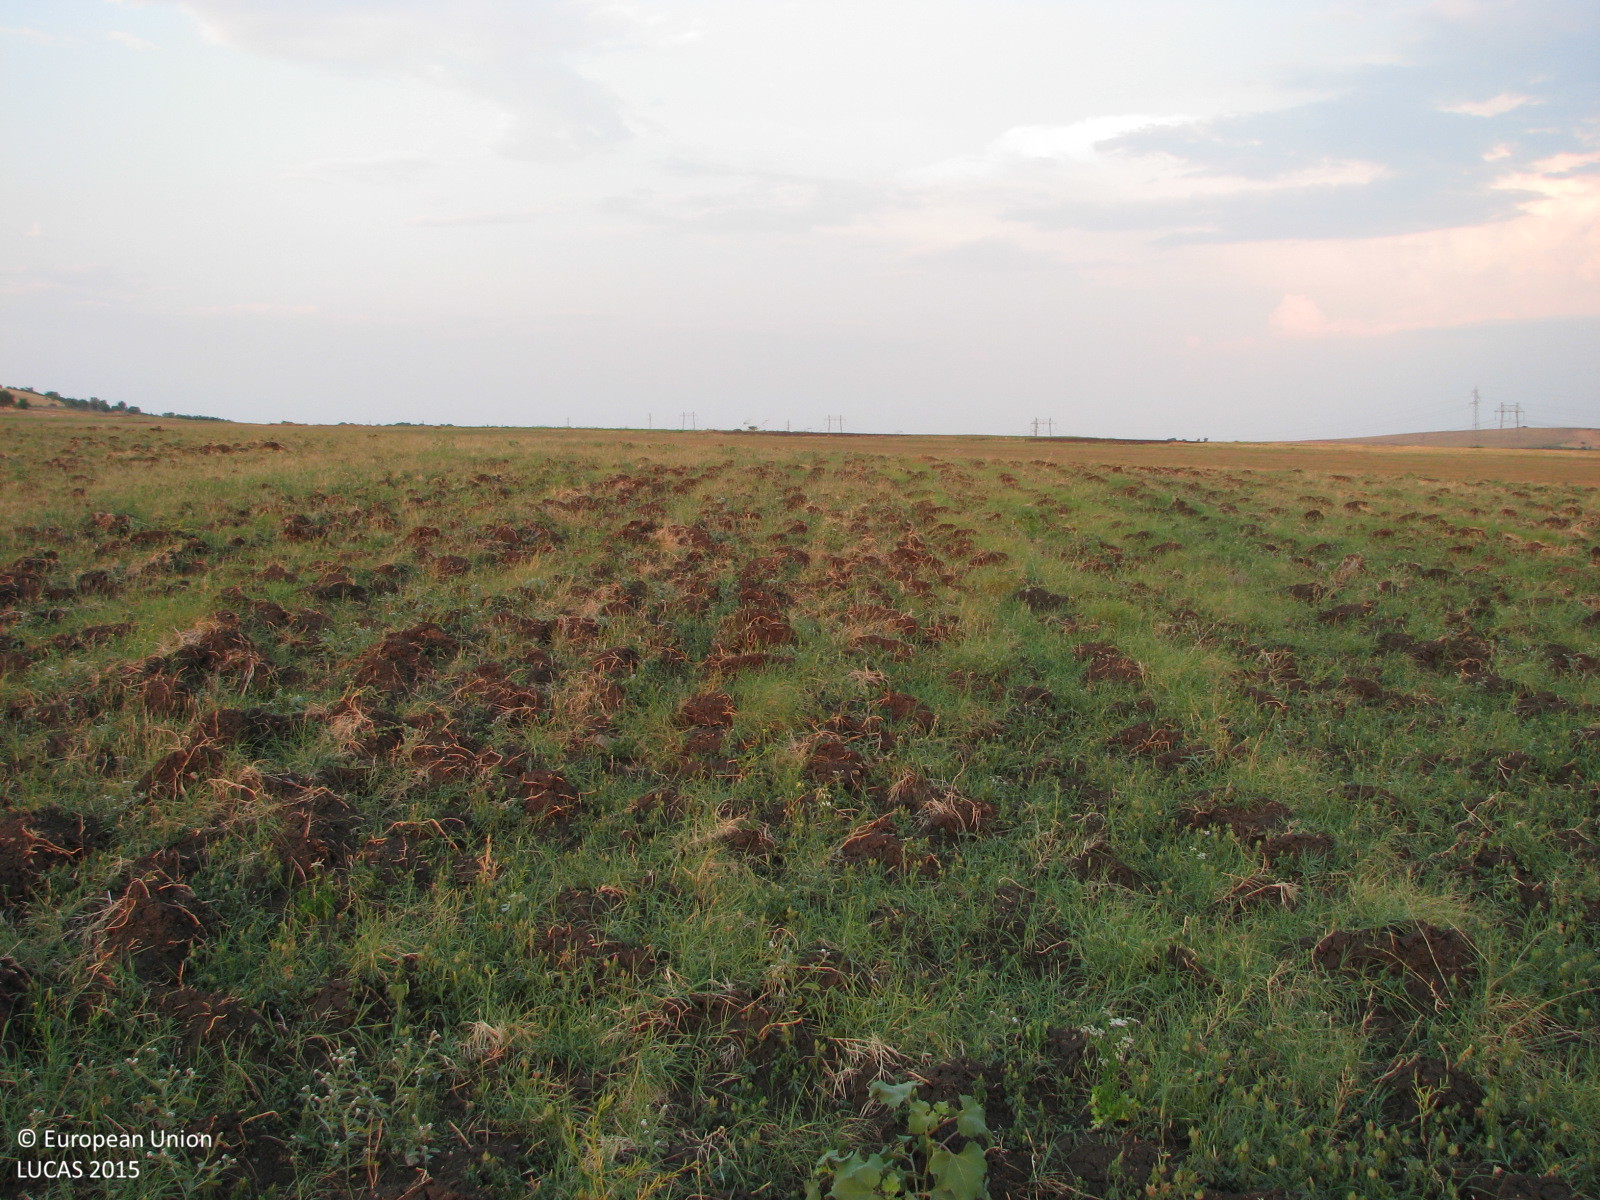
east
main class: Grassland
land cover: Spontaneously vegetated surfaces
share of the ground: > 75 %
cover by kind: herbaceous plants 90 %, unconsolidated bare surface 10 %
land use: Agriculture (excluding fallow land and kitchen gardens)
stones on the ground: < 10 %
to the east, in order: Spontaneously vegetated surfaces; Other bare soil; Grassland without tree/shrub cover; Tracks; Grass margins; Other non-permanent industrial crops
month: August
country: BG
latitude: 42.1899
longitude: 26.3965
